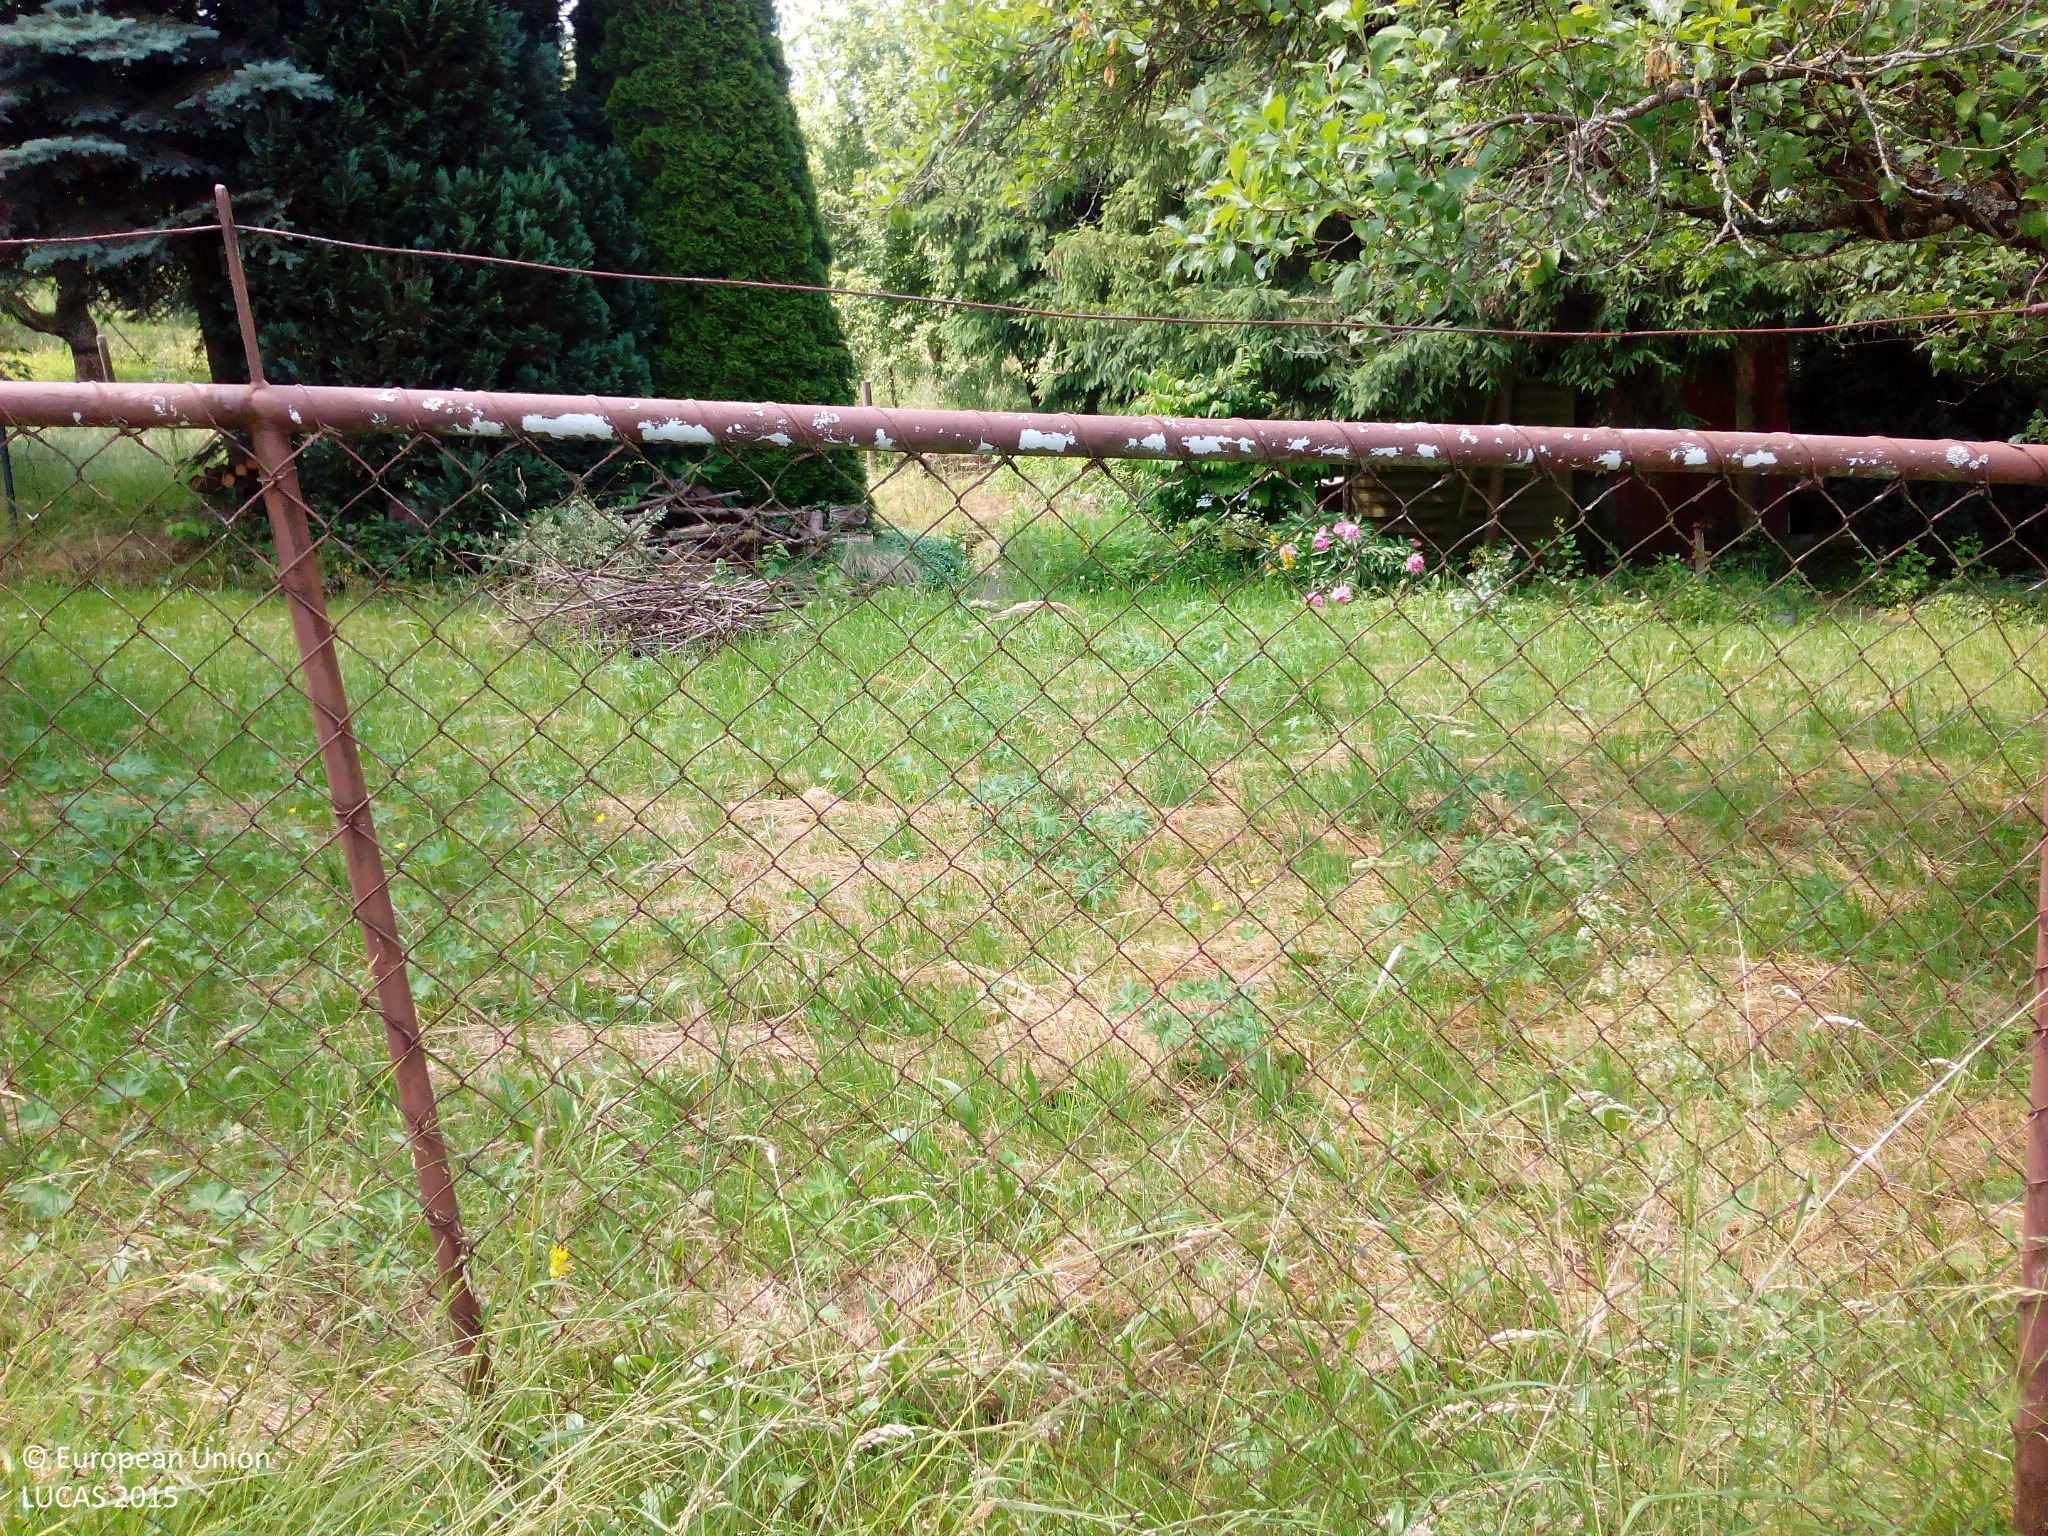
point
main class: Cropland
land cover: Apple fruit
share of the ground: 50 - 75 %
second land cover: Grassland without tree/shrub cover
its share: 50 - 75 %
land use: Agriculture (excluding fallow land and kitchen gardens)
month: June
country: DE
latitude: 48.8697
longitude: 9.4140
